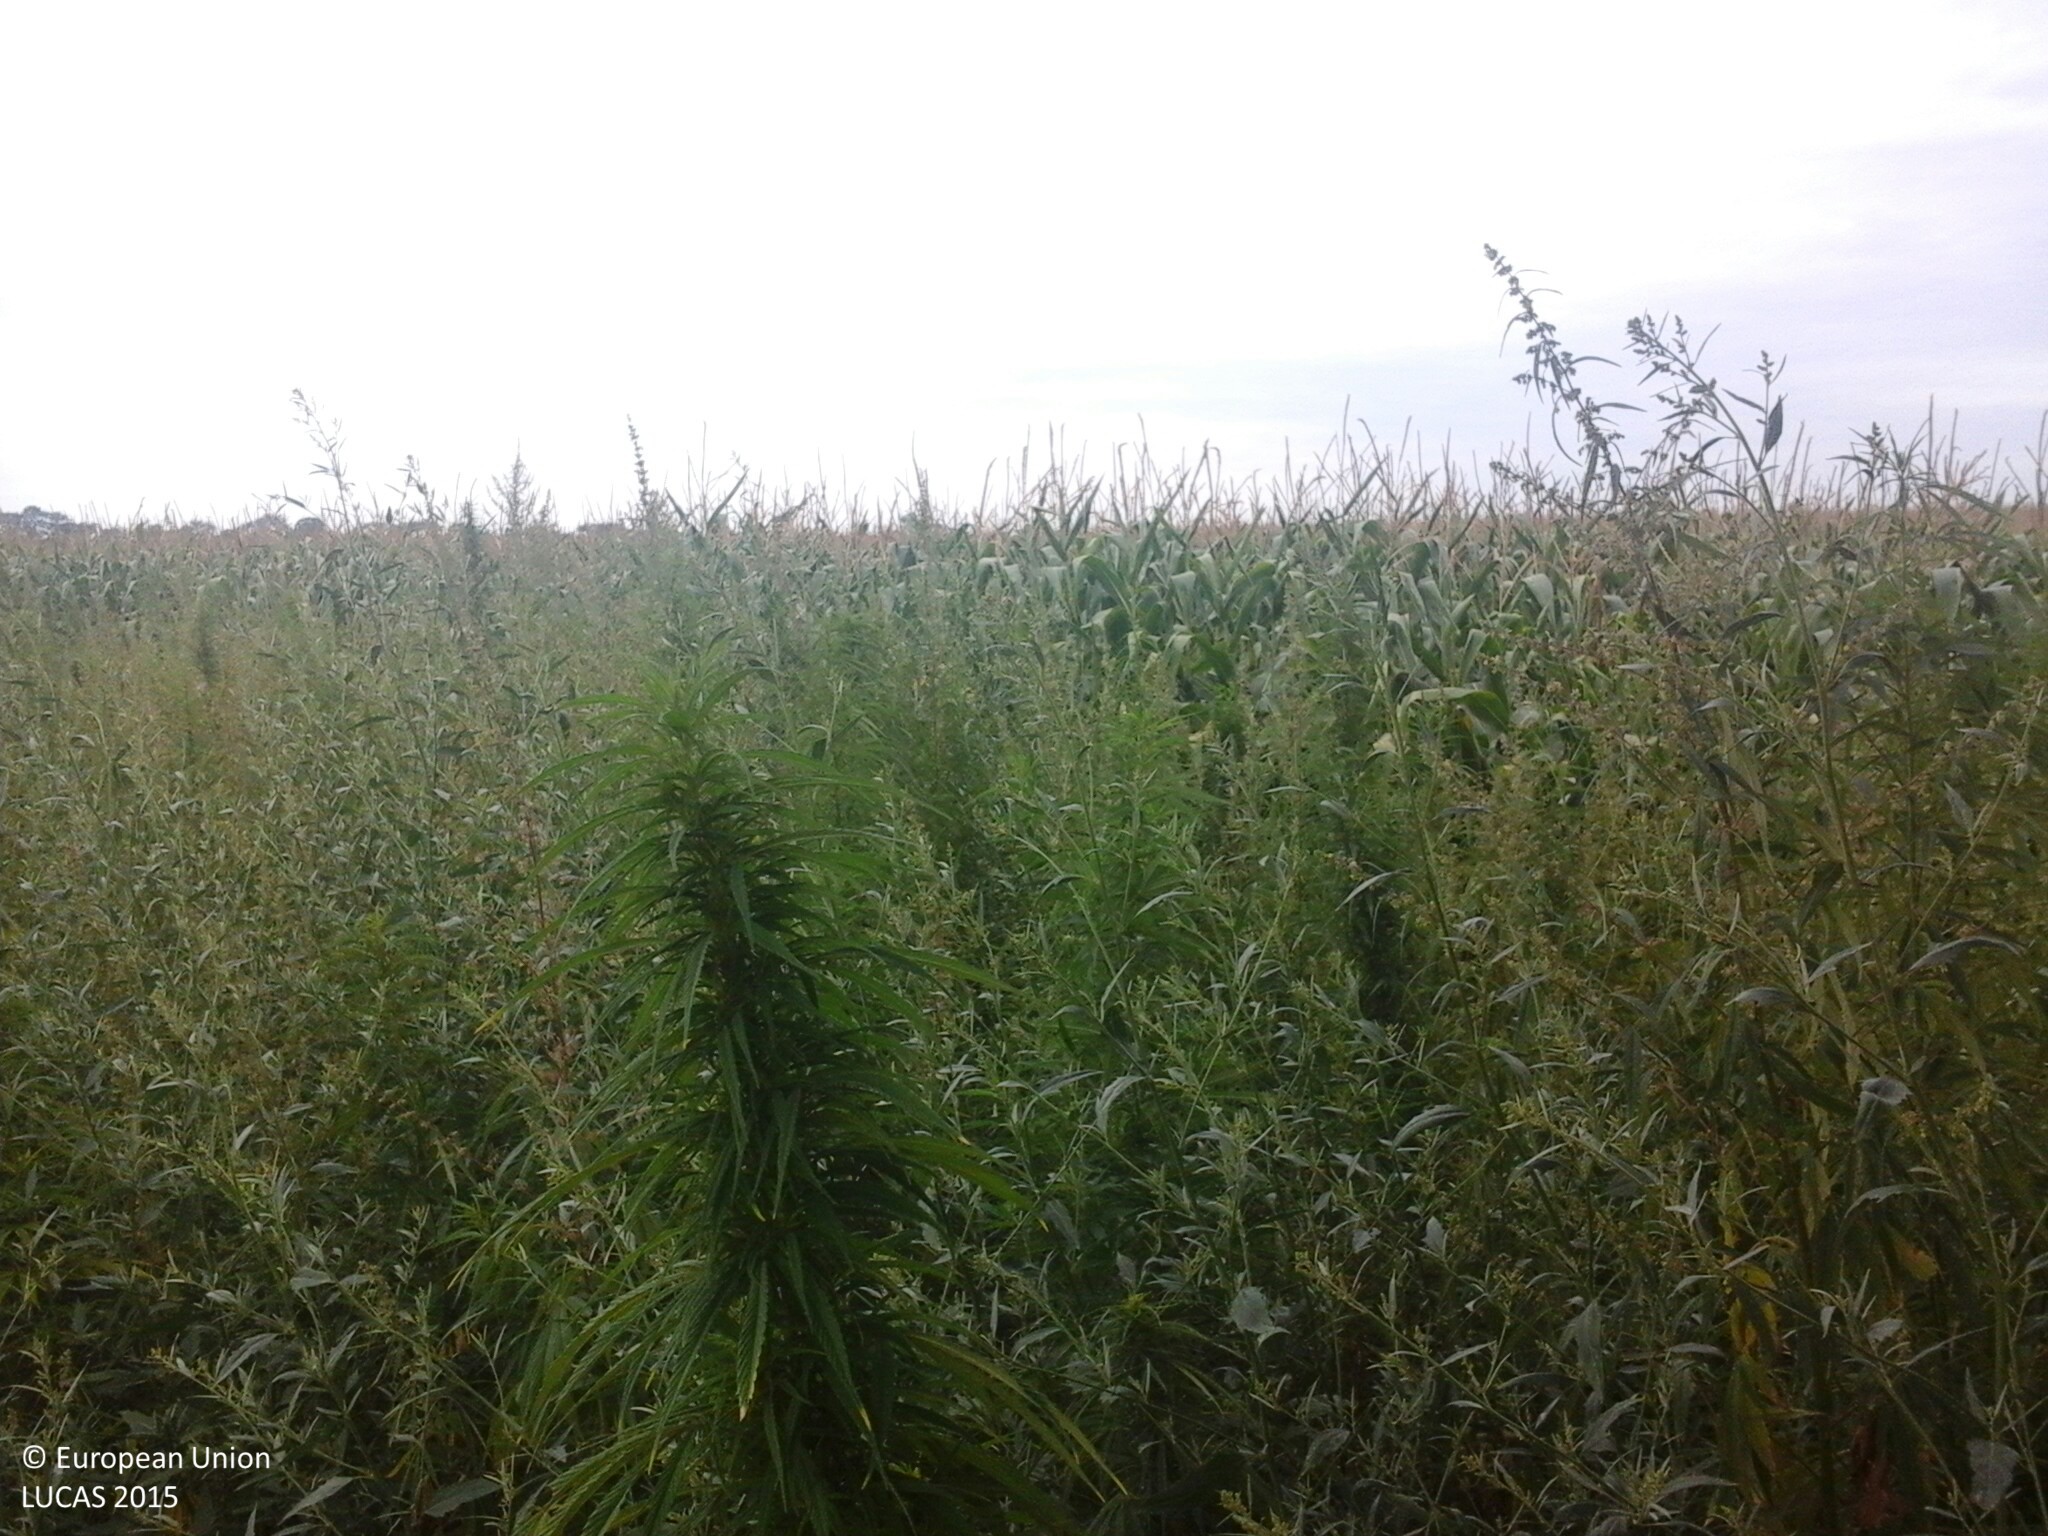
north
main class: Cropland
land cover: Maize
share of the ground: > 75 %
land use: Agriculture (excluding fallow land and kitchen gardens)
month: July
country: HU
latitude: 46.9589
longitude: 18.4350
